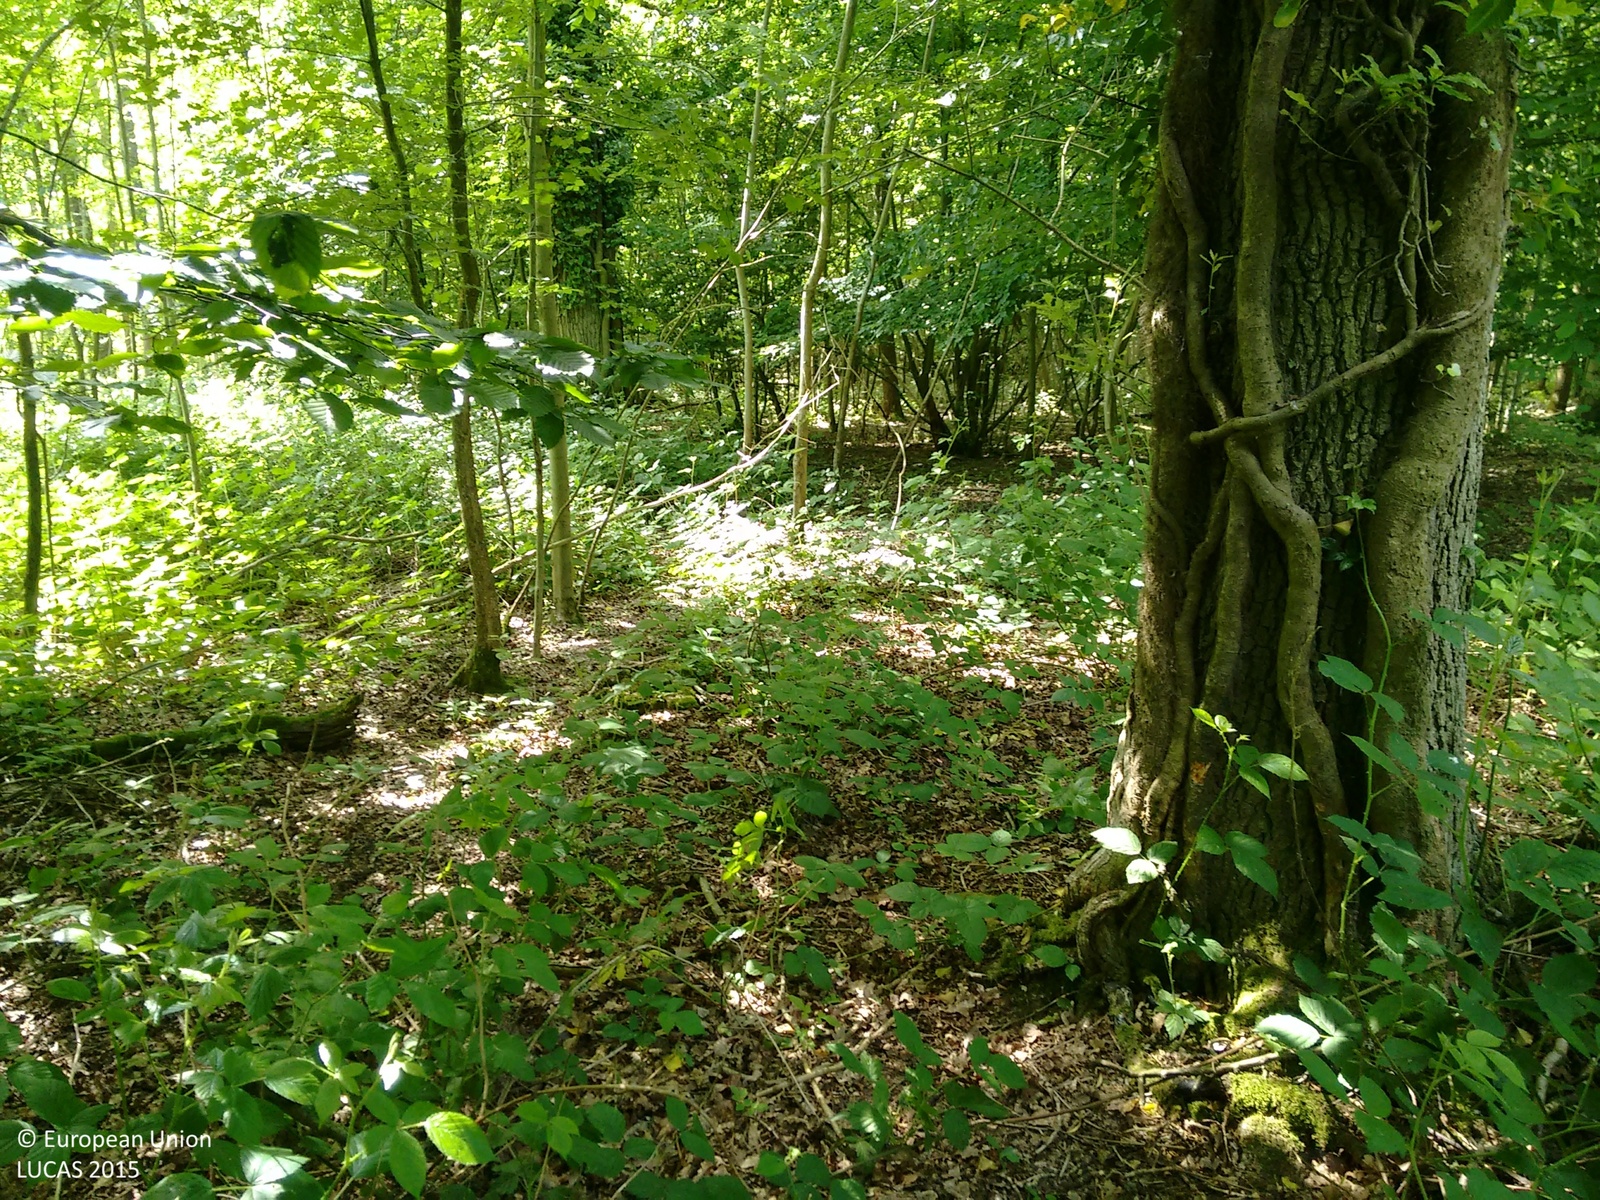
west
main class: Woodland
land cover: Broadleaved woodland
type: mesophytic deciduous forest
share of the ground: > 75 %
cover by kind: broadleaved forest trees 60 %, shrubs 35 %, herbaceous plants 5 %
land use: Forestry
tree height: > 5 m
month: June
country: GB
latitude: 50.9578
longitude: 0.6485
